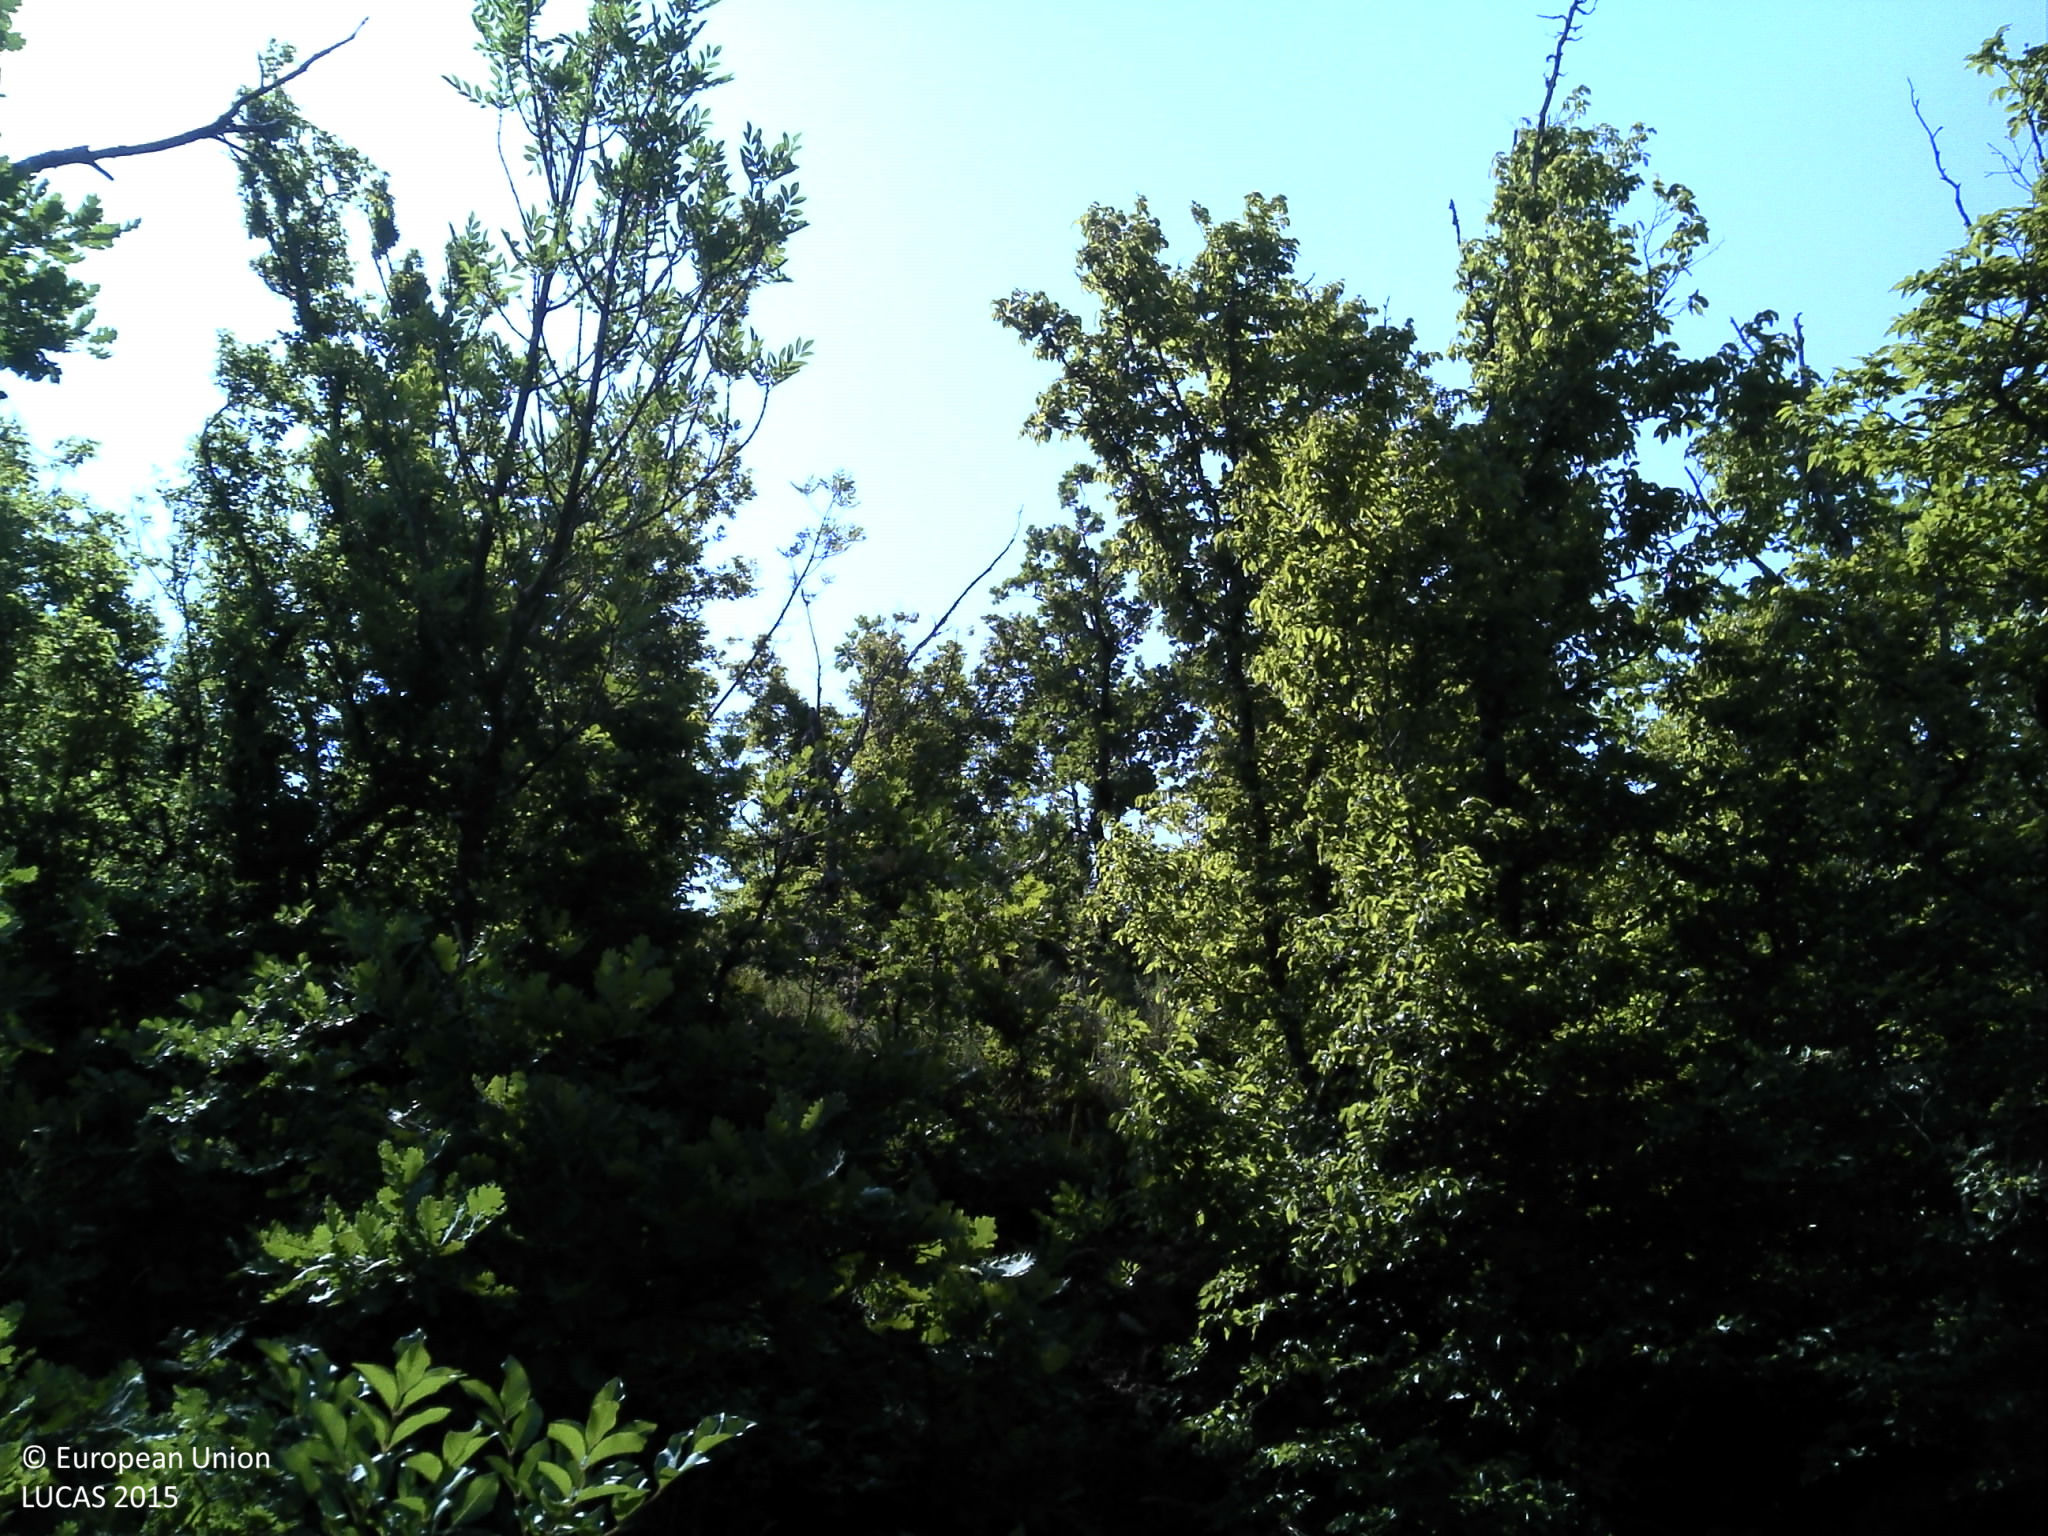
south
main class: Woodland
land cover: Broadleaved woodland
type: thermophilous deciduous forest
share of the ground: 50 - 75 %
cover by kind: broadleaved forest trees 45 %, shrubs 25 %, unconsolidated bare surface 15 %, herbaceous plants 10 %, consolidated bare surface 5 %
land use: Semi-natural and natural areas not in use
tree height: > 5 m
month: July
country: HR
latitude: 44.0313
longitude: 16.3187
